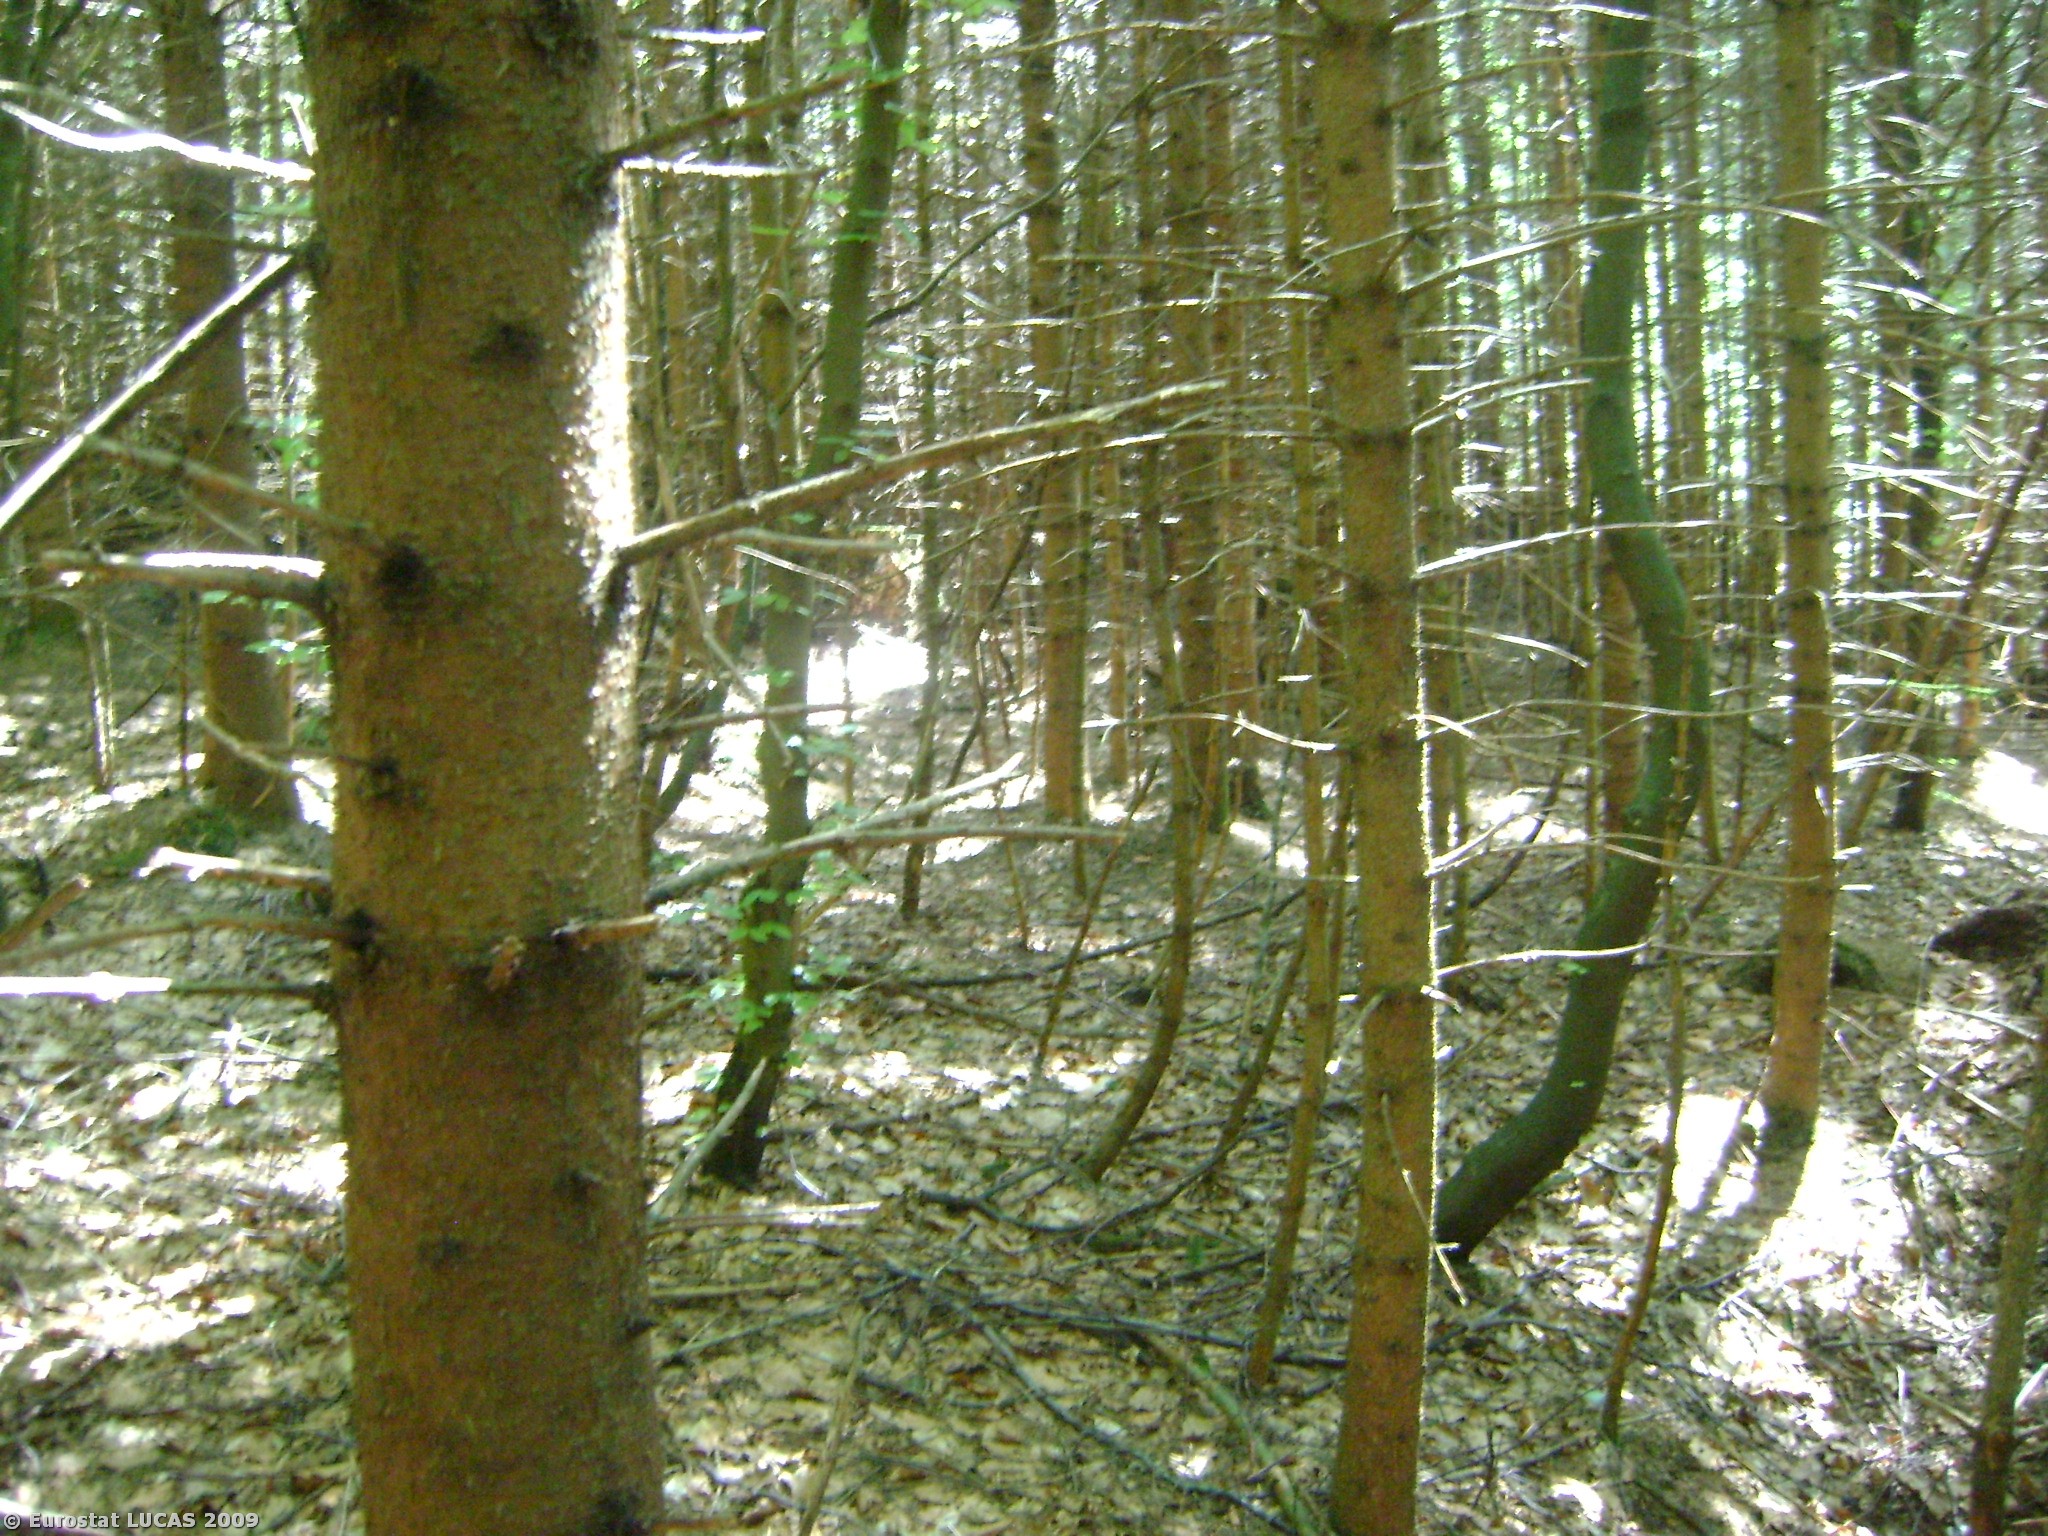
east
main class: Woodland
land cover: Mixed woodland
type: hemiboreal forest and nemoral coniferous forest and mixed broadleaved-coniferous forest
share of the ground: > 75 %
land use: Forestry
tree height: > 5 m
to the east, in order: Mixed woodland; Tracks; Mixed woodland; Tracks; Mixed woodland; Tracks; Coniferous woodland
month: June
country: AT
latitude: 48.0298
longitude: 13.3113
